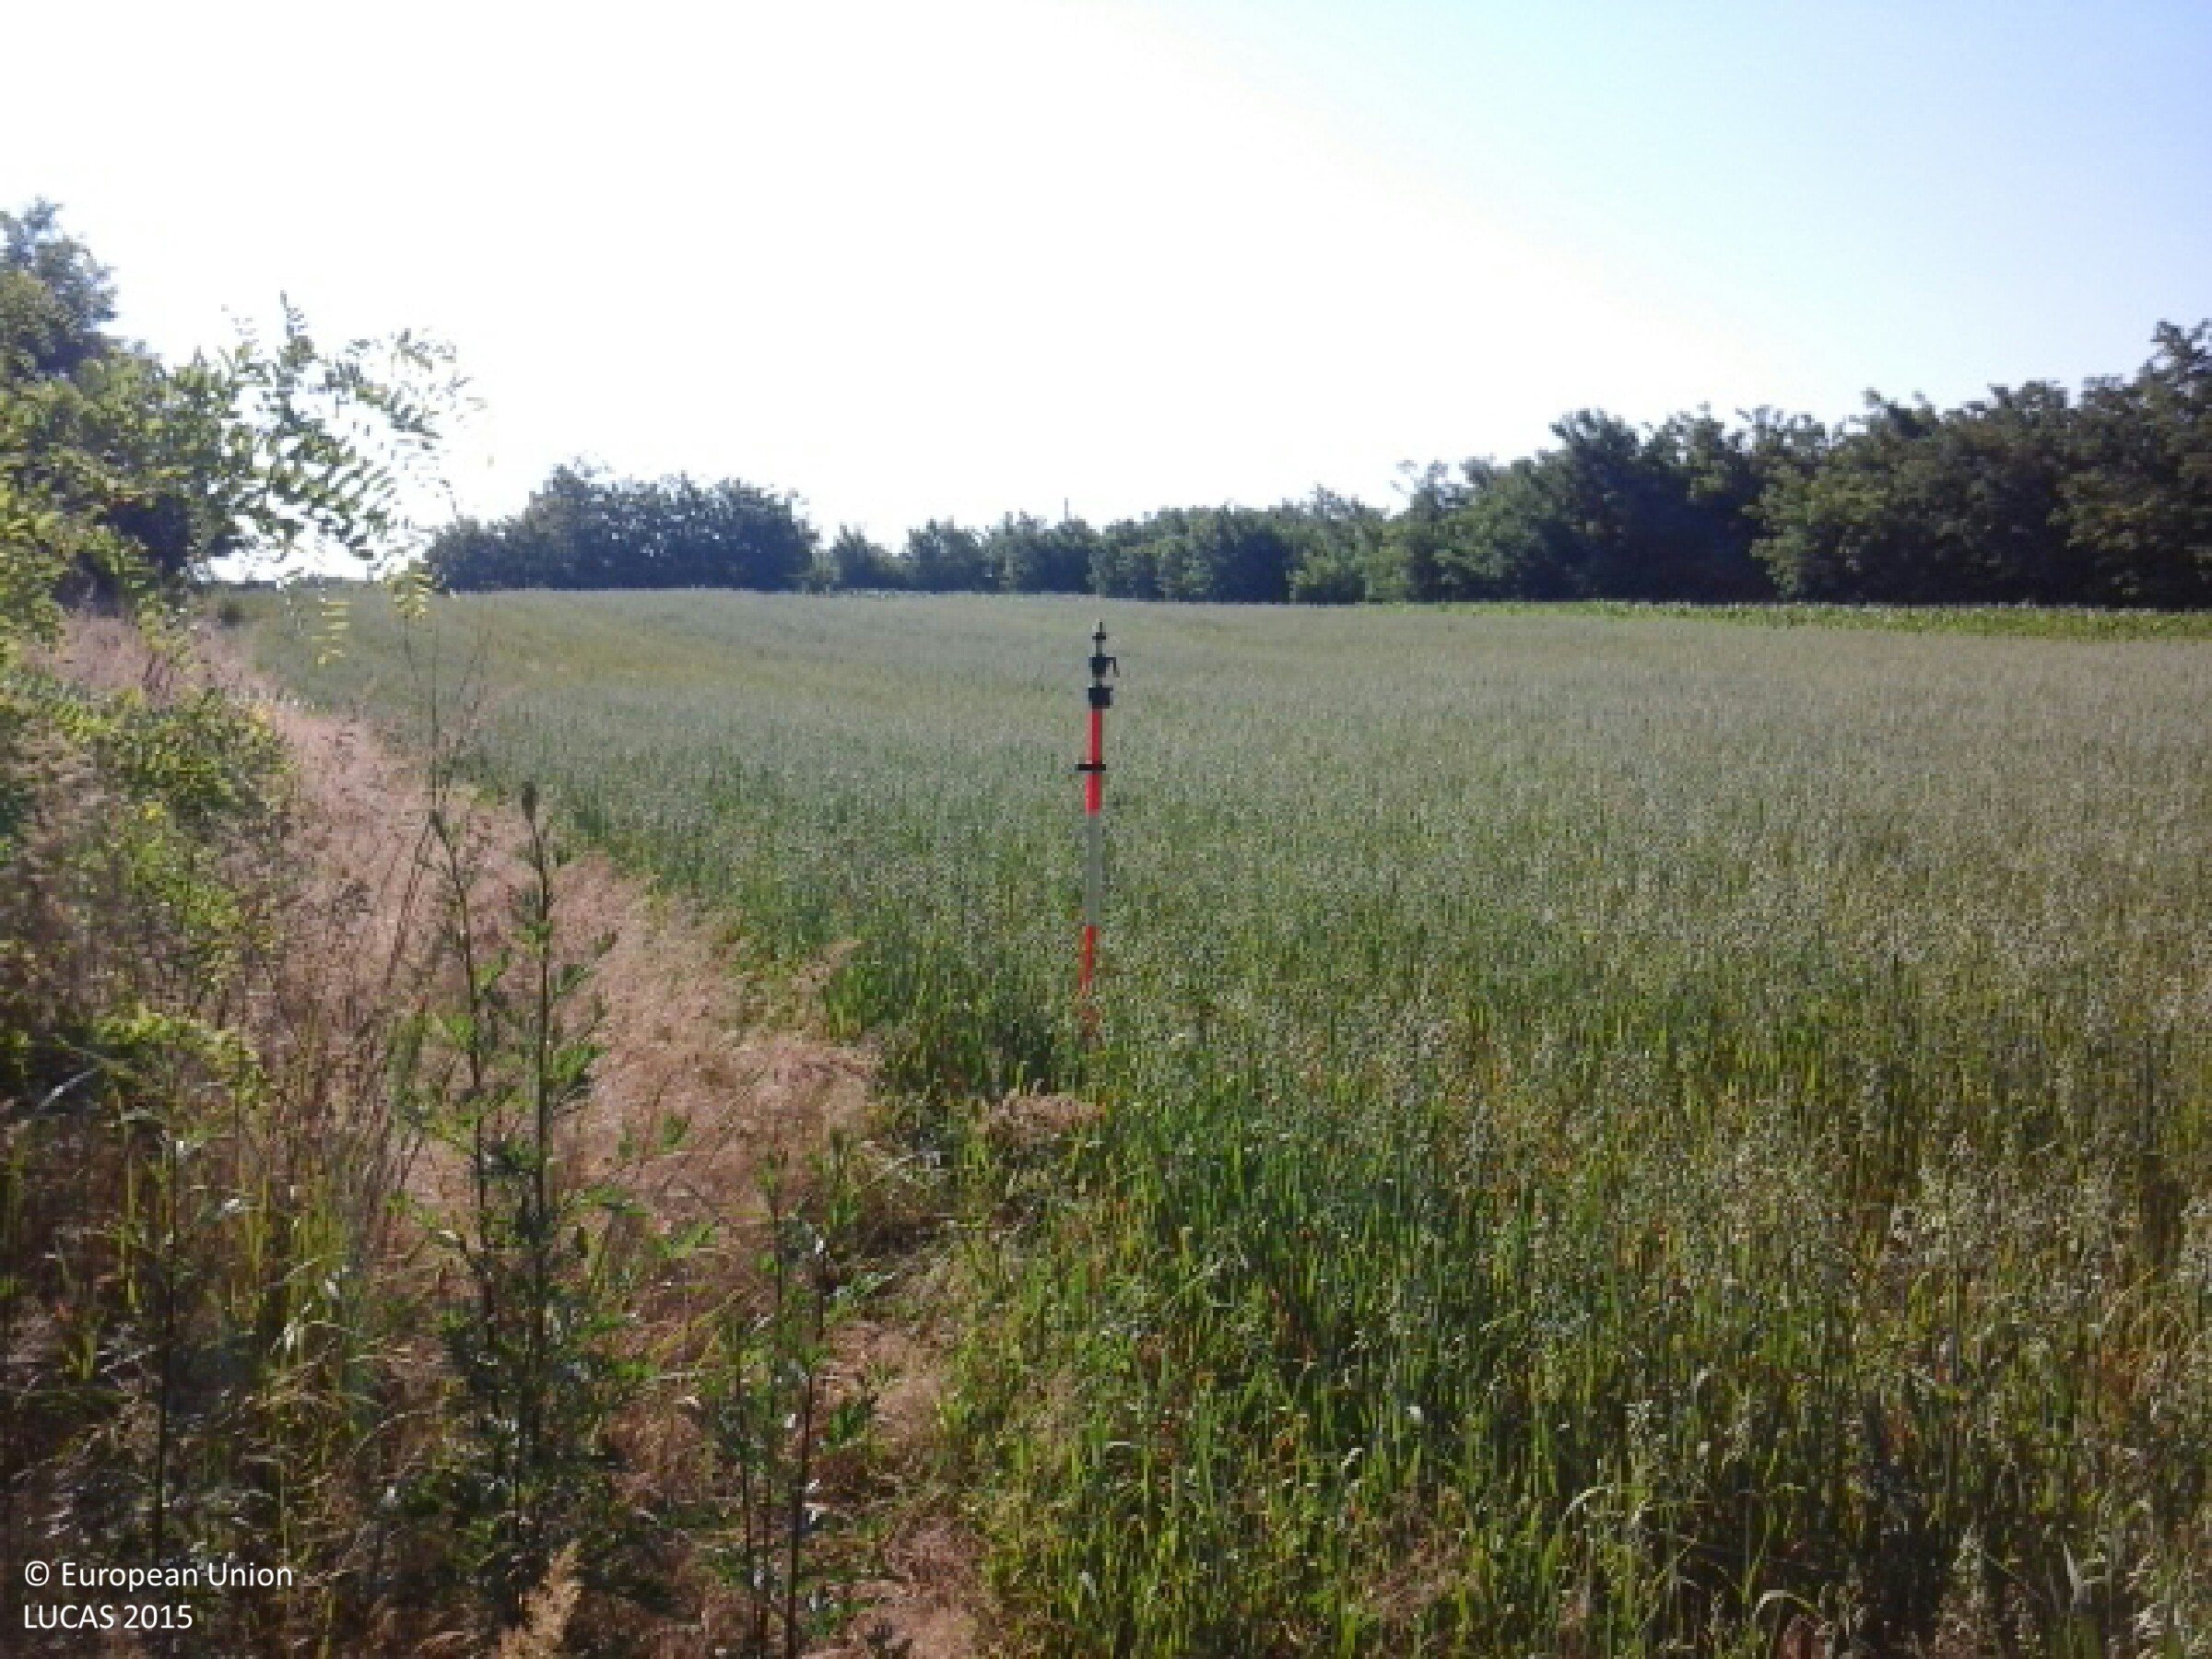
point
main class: Cropland
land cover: Oats
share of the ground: 50 - 75 %
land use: Agriculture (excluding fallow land and kitchen gardens)
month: June
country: HU
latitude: 47.9987
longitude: 21.6943
